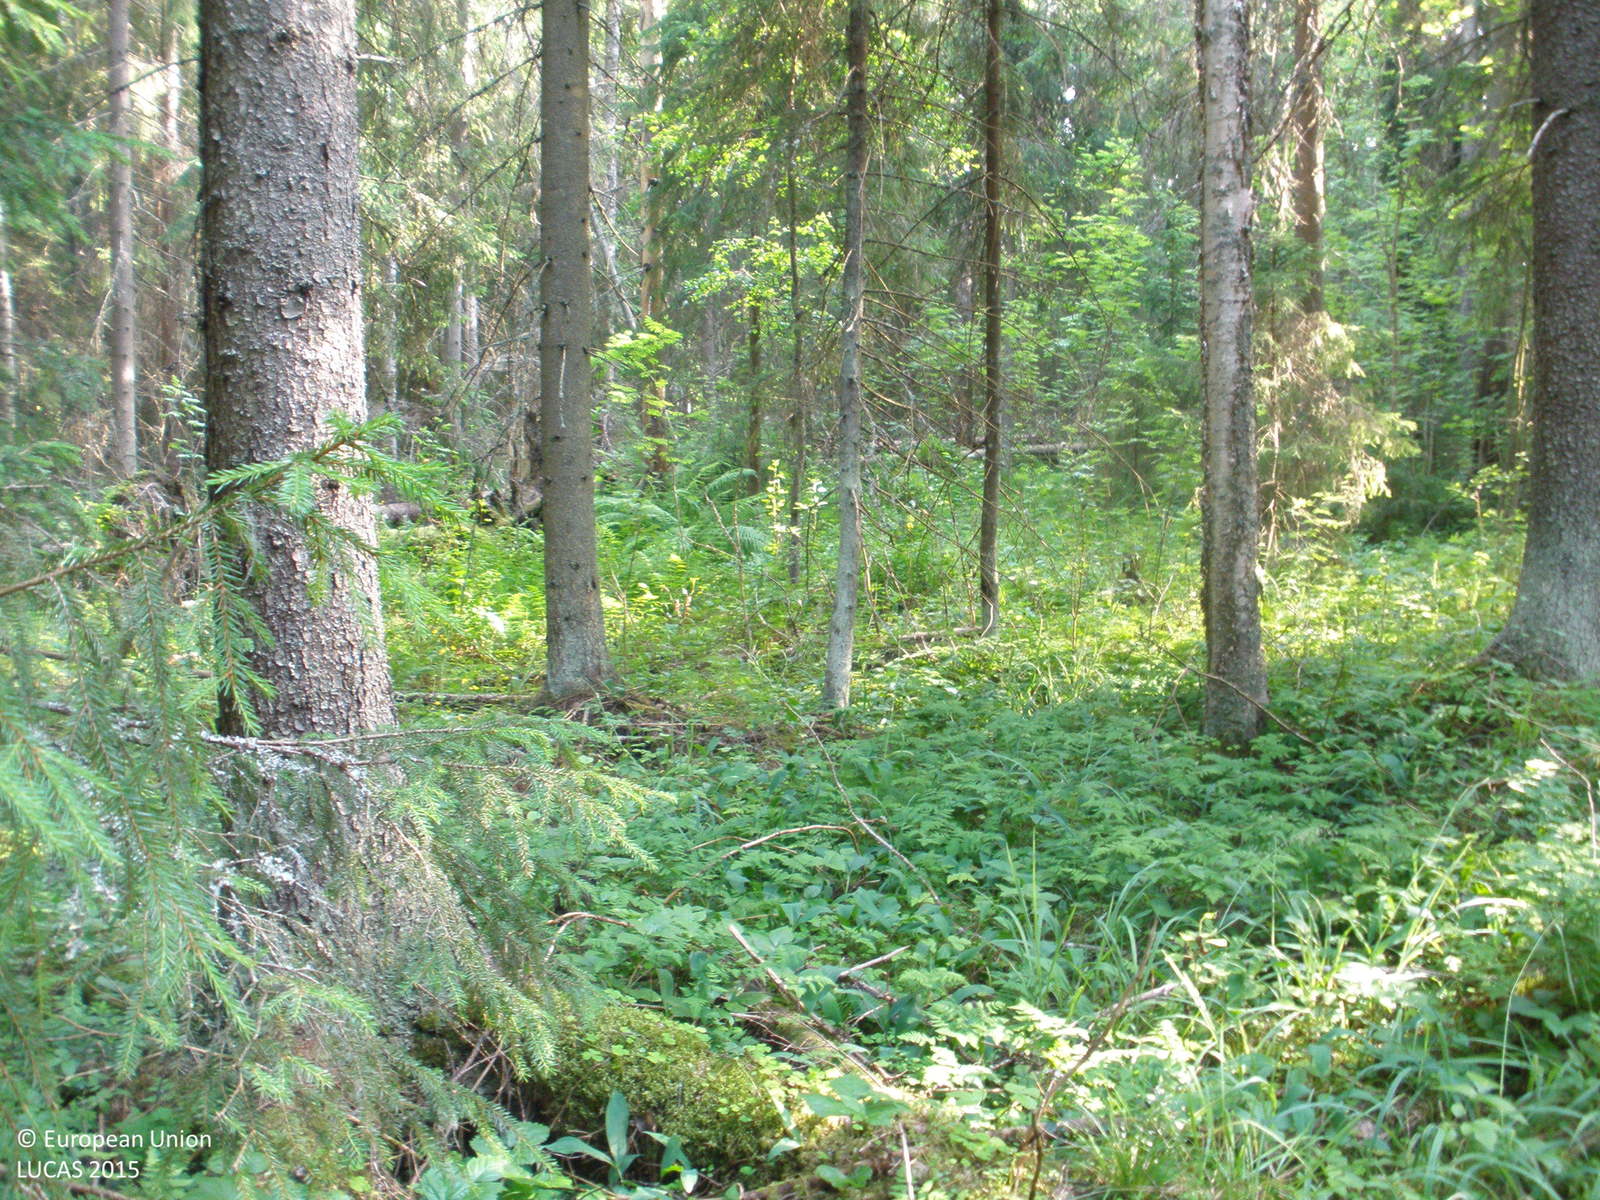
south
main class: Woodland
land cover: Spruce dominated coniferous woodland
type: boreal forest
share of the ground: > 75 %
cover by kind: coniferous forest trees 85 %, lichens and mosses 10 %, herbaceous plants 5 %
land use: Forestry
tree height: > 5 m
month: July
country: FI
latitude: 61.4168
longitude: 23.8580
